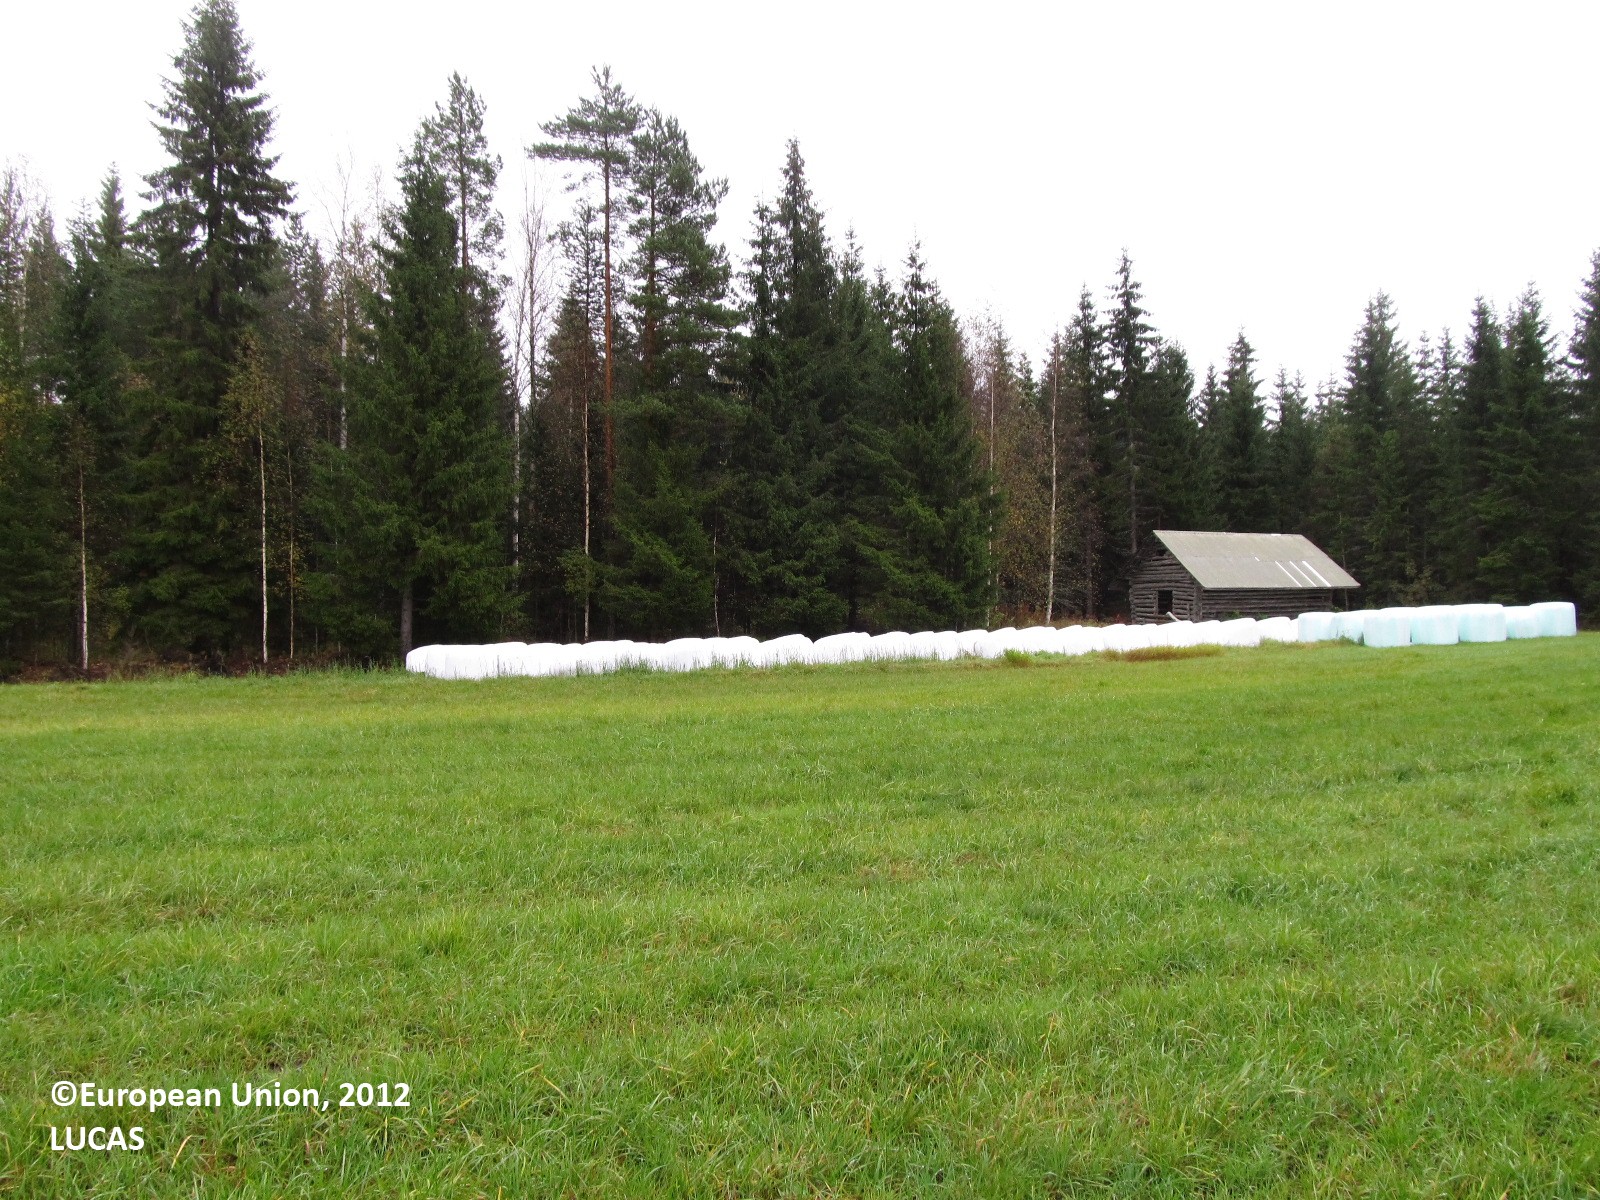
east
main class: Cropland
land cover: Temporary grasslands
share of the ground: > 75 %
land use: Agriculture (excluding fallow land and kitchen gardens)
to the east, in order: Temporary grasslands; Ditches and canals; Spruce dominated coniferous woodland; Tracks; Spruce dominated coniferous woodland; Grassland without tree/shrub cover; Electric lines; Grassland without tree/shrub cover; Tracks; Grassland without tree/shrub cover
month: September
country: FI
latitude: 62.5045
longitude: 27.9471
